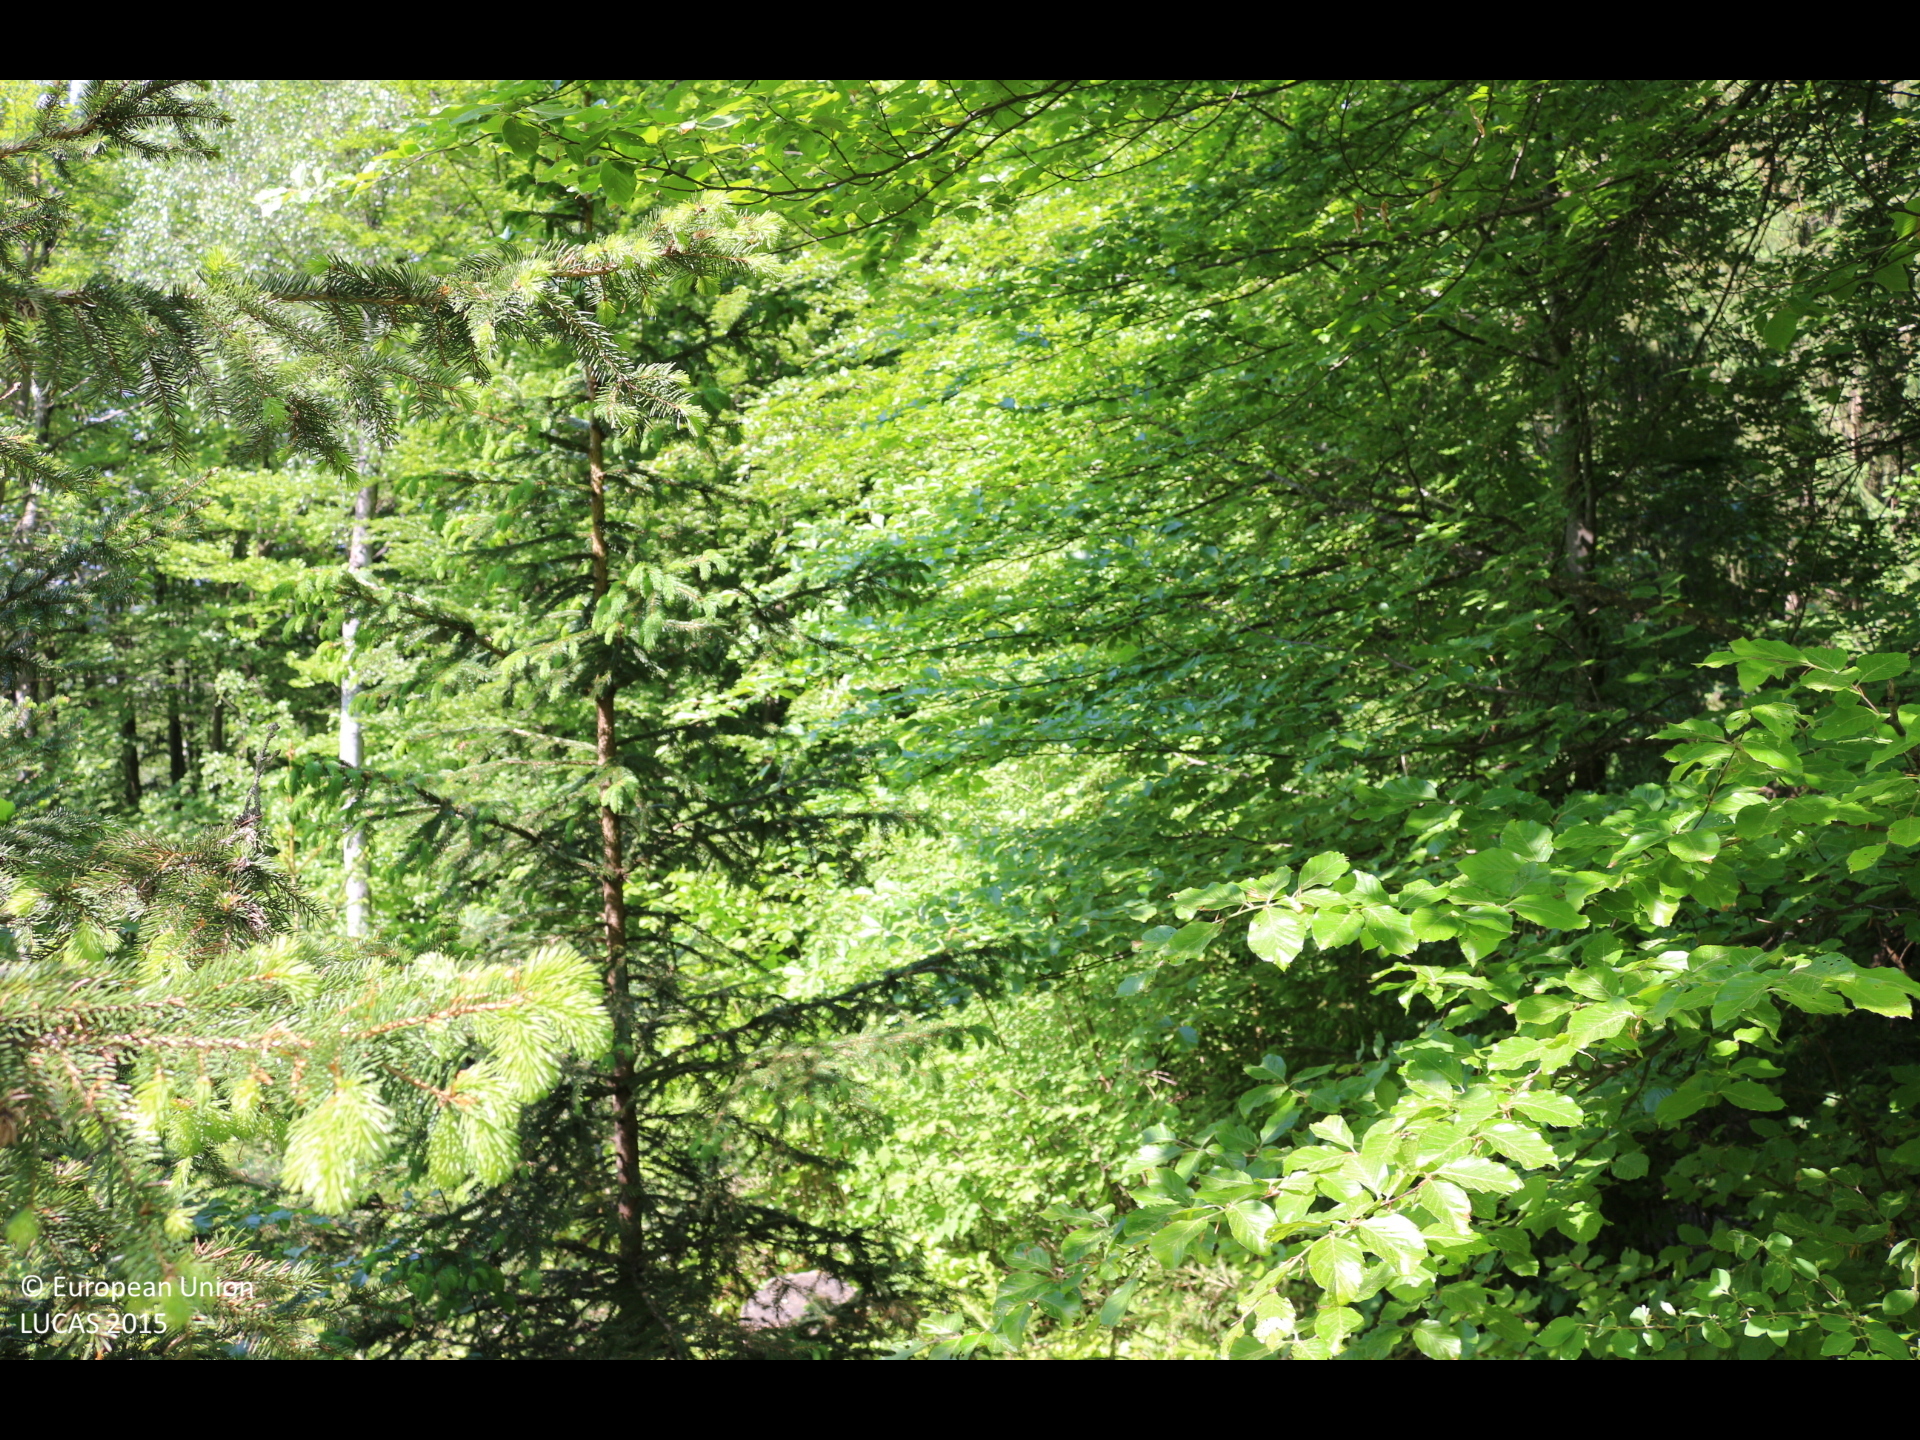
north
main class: Woodland
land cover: Spruce dominated mixed woodland
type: alpine coniferous forest
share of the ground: > 75 %
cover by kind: coniferous forest trees 40 %, broadleaved forest trees 40 %, shrubs 20 %
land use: Forestry
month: May
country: AT
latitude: 46.7822
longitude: 14.4381
